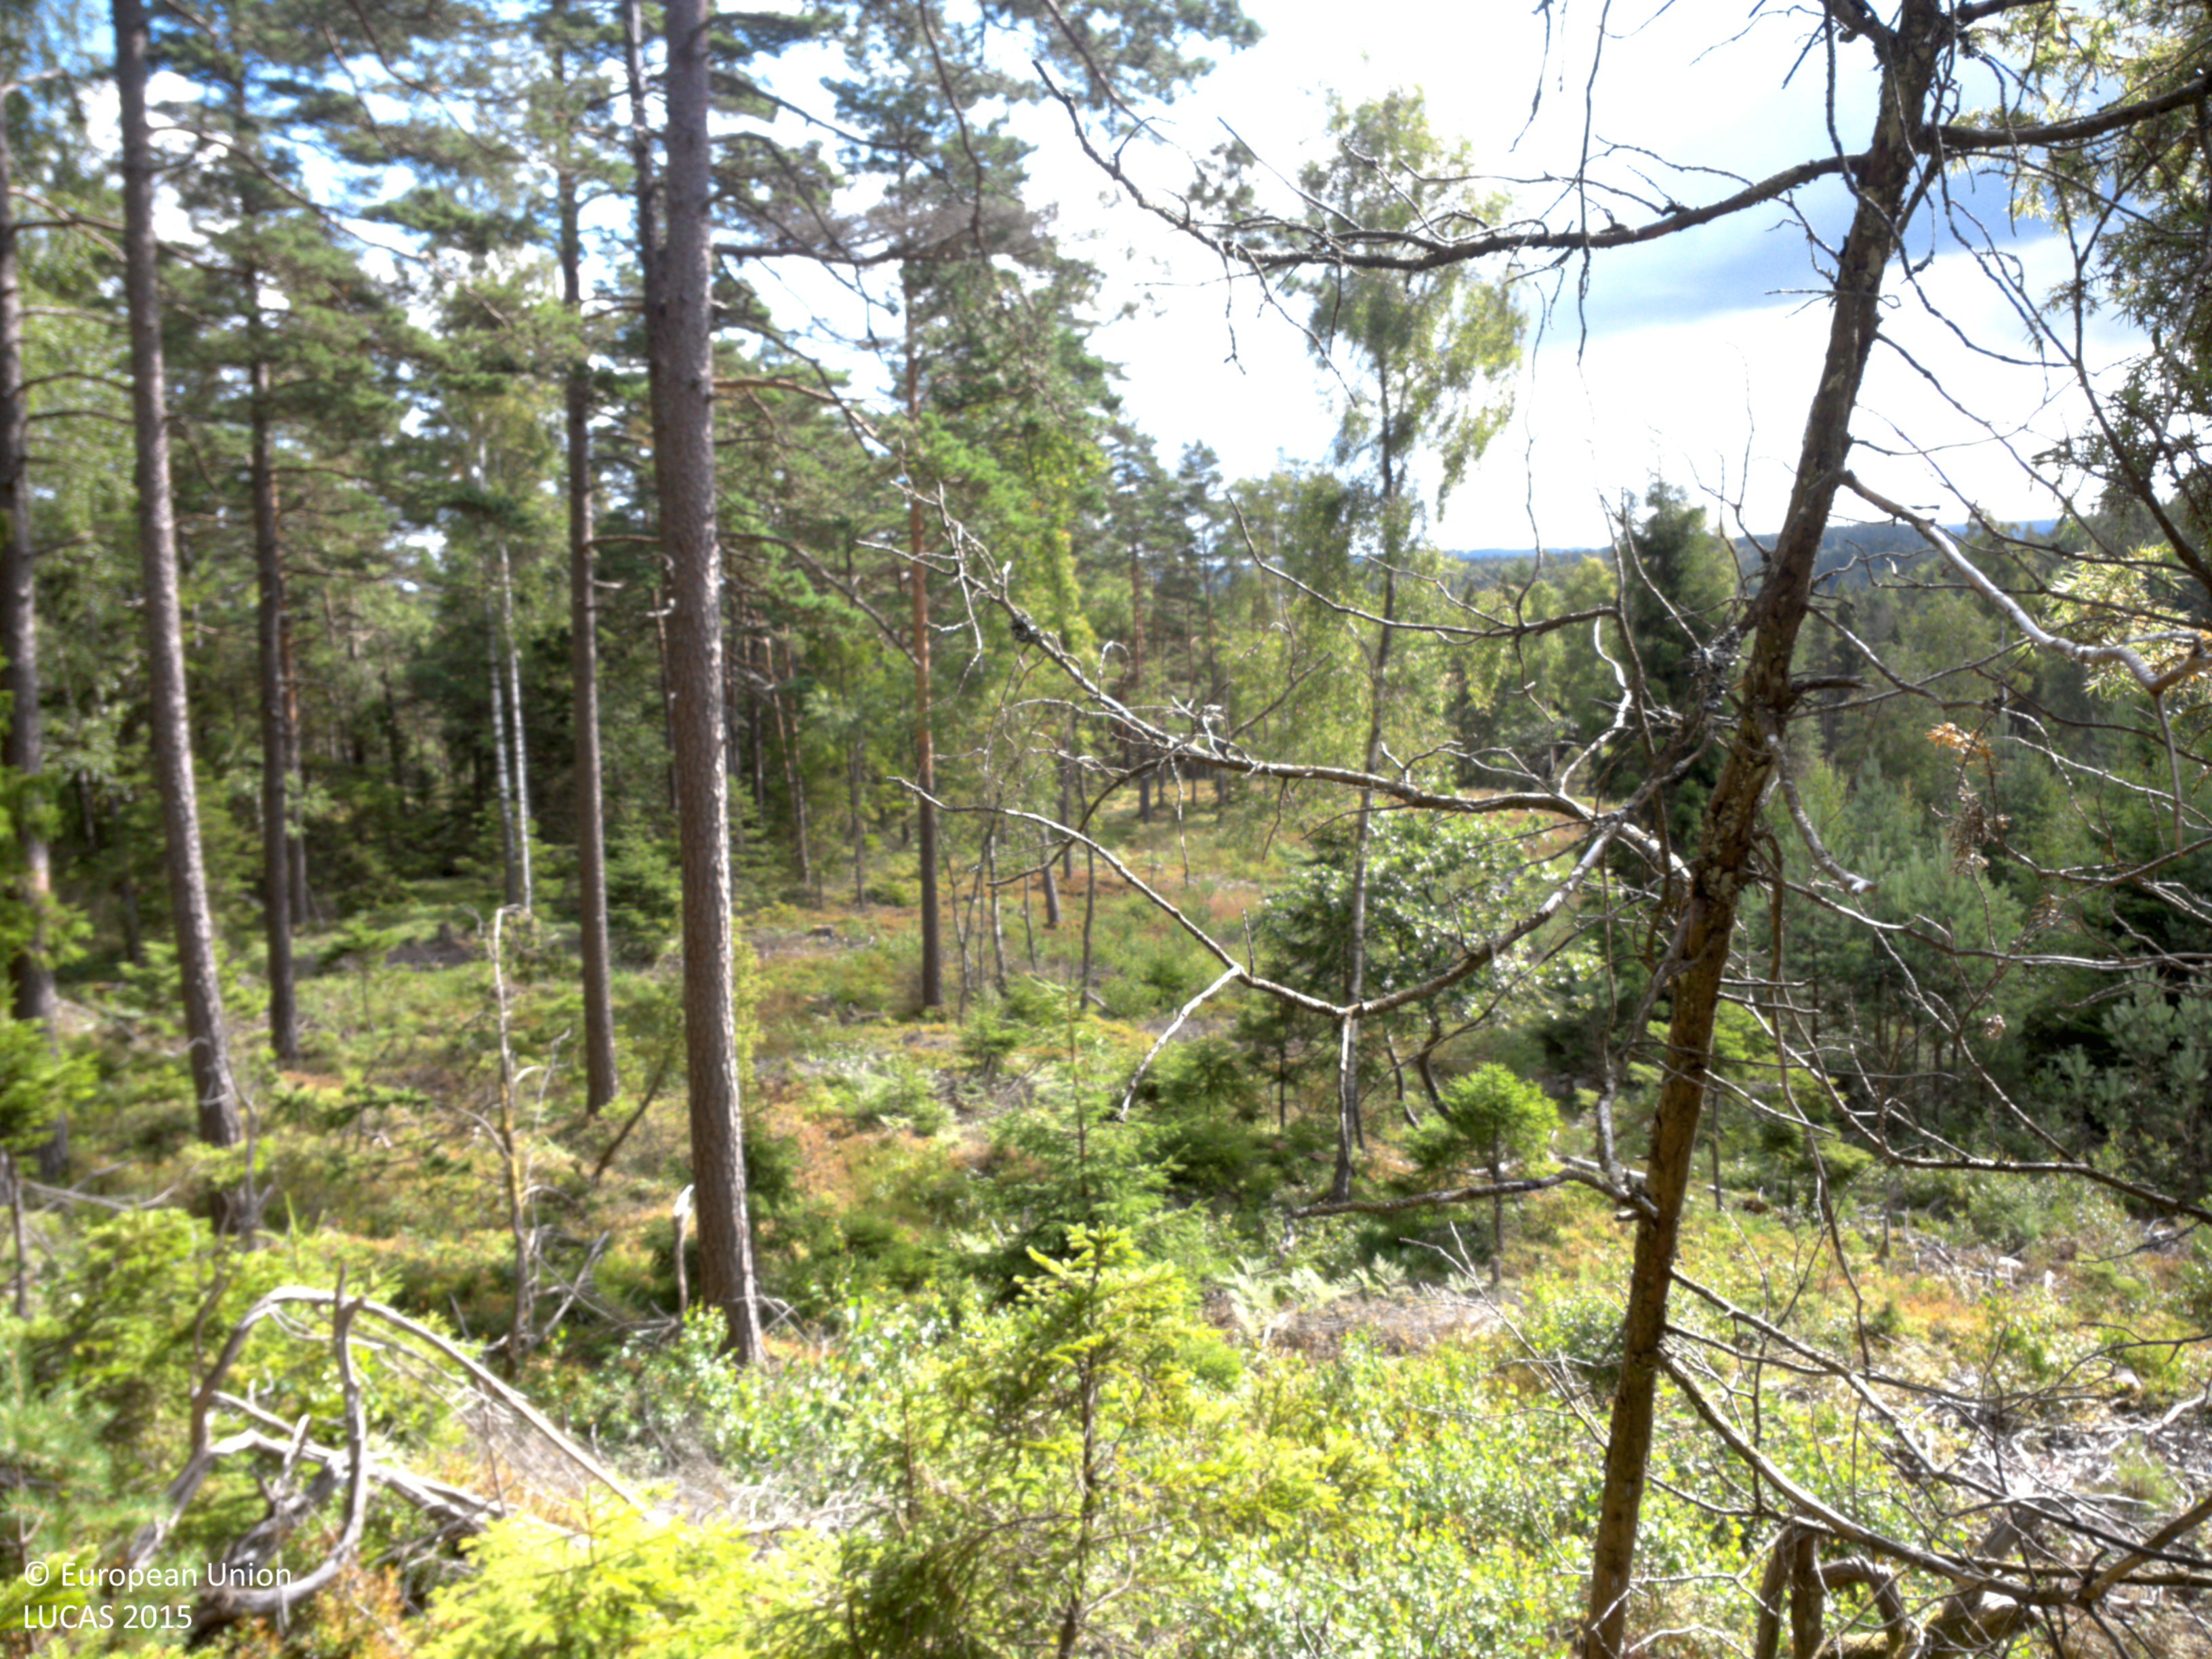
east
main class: Woodland
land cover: Other coniferous woodland
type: boreal forest
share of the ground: 25 - 50 %
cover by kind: coniferous forest trees 40 %, shrubs 35 %, lichens and mosses 10 %, unconsolidated bare surface 10 %, broadleaved forest trees 5 %
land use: Forestry
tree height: > 5 m
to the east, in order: Other coniferous woodland; Spruce dominated mixed woodland; Dry stone walls; Spruce dominated mixed woodland; Shrubland with sparse tree cover; Other mixed woodland; Dry stone walls; Other coniferous woodland; Spruce dominated coniferous woodland; Rivers and streams; Spruce dominated coniferous woodland; Spruce dominated mixed woodland; Rivers and streams; Pine dominated mixed woodland
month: July
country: SE
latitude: 58.2436
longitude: 11.7852
